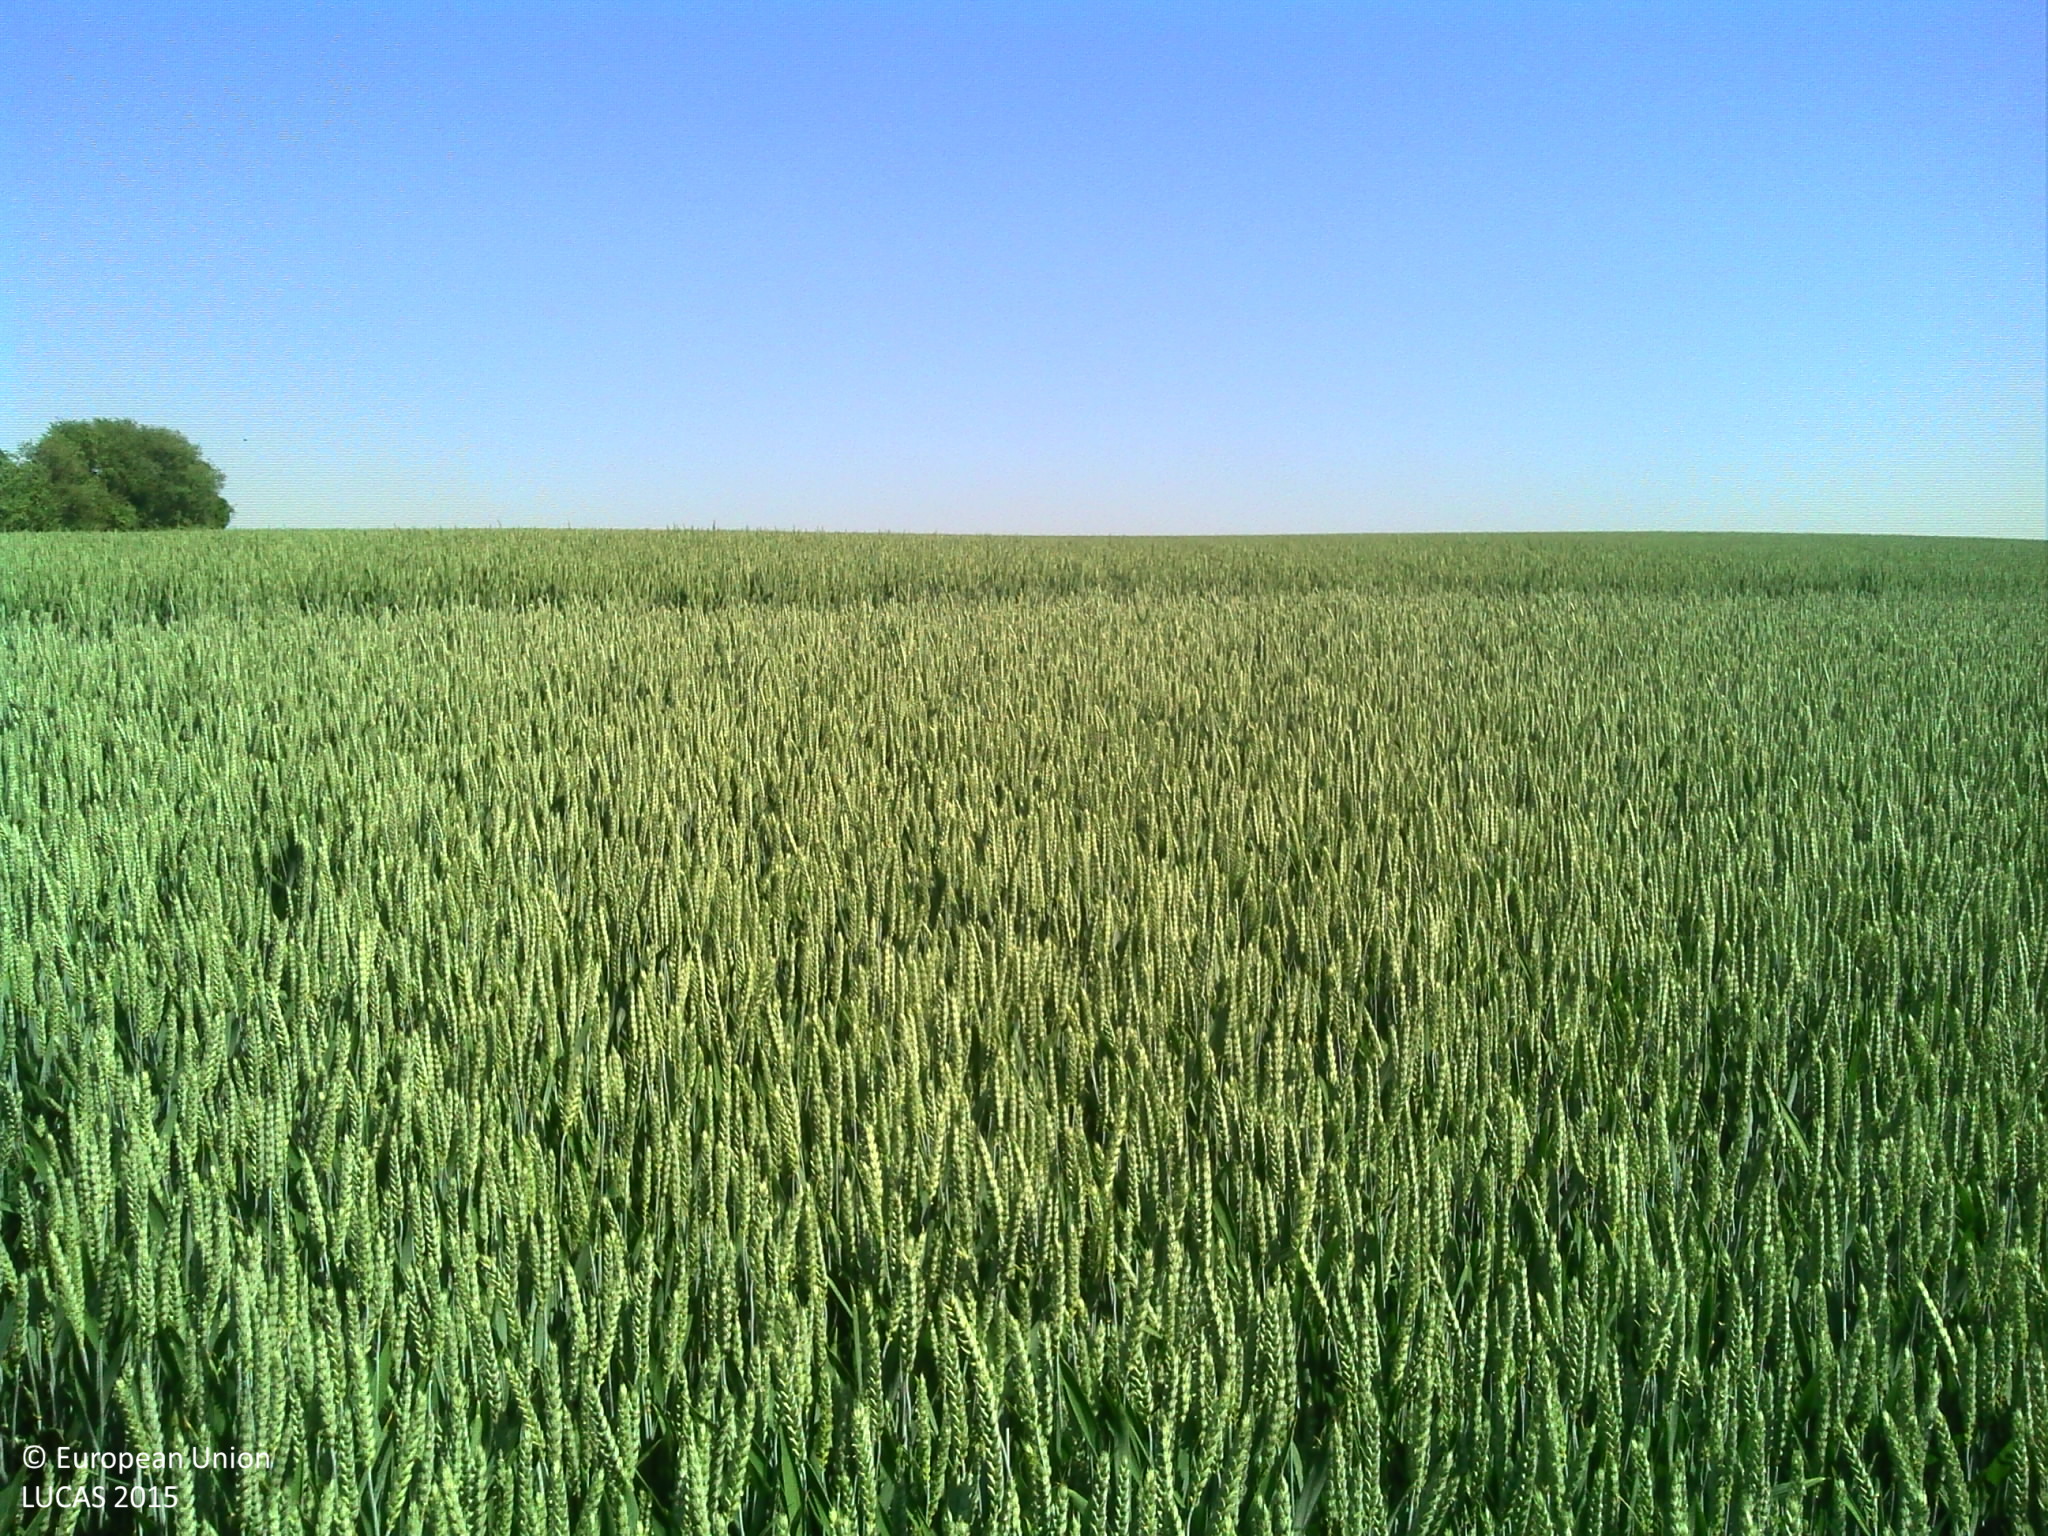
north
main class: Cropland
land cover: Common wheat
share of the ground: > 75 %
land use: Agriculture (excluding fallow land and kitchen gardens)
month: June
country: FR
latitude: 49.7220
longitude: 4.0440
